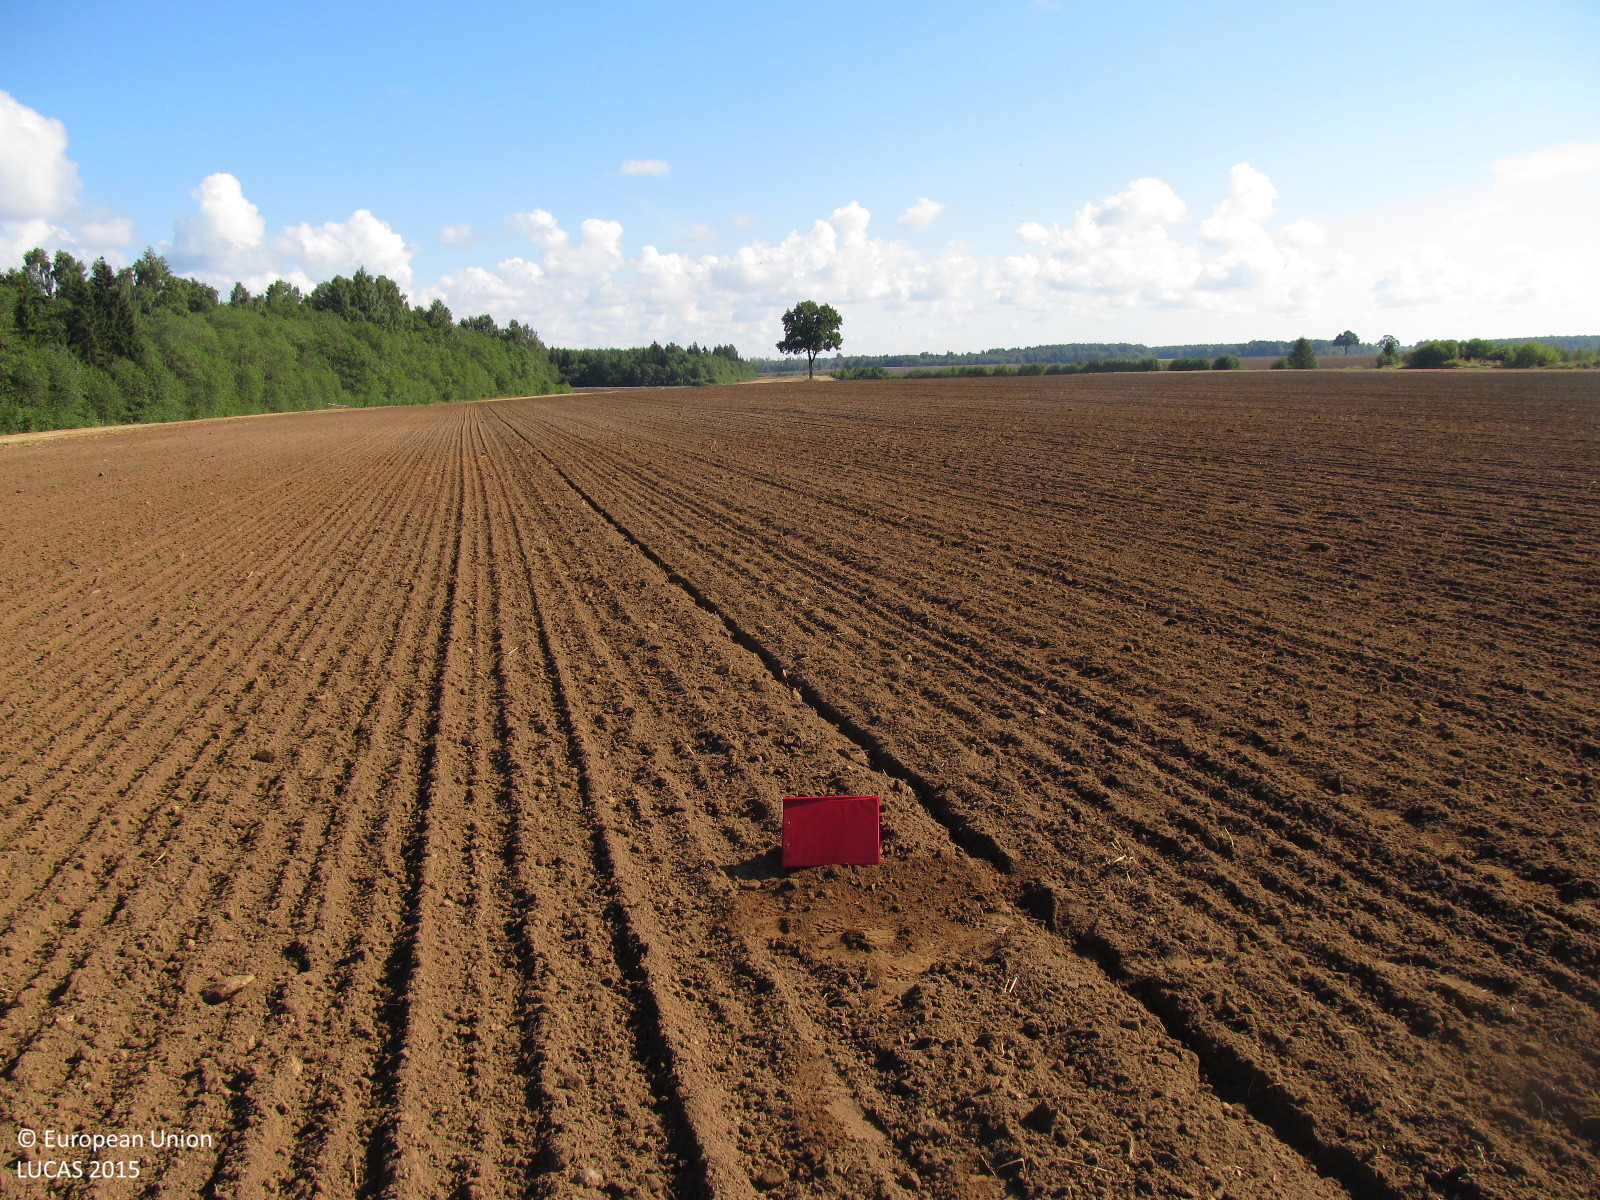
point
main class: Cropland
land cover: Common wheat
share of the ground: > 75 %
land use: Agriculture (excluding fallow land and kitchen gardens)
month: September
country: LT
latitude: 56.1471
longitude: 22.9594
